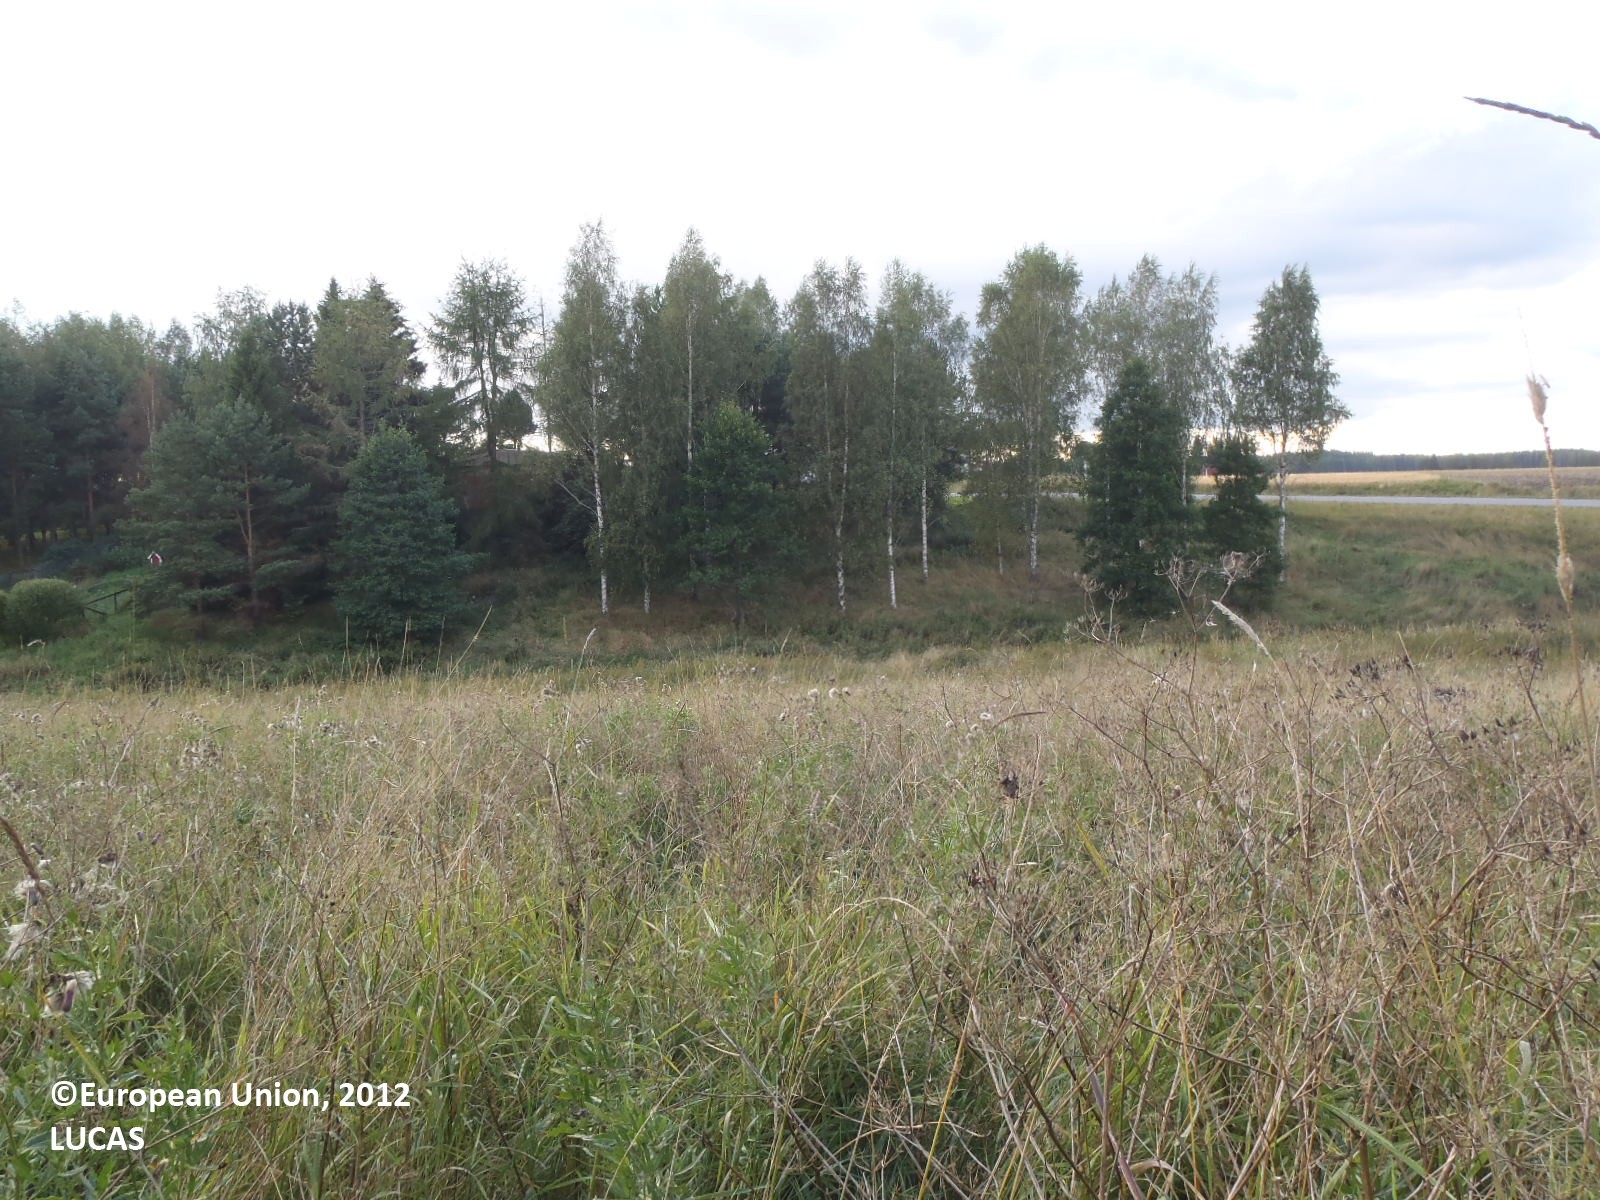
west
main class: Grassland
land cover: Grassland without tree/shrub cover
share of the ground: > 75 %
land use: Fallow land
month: August
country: FI
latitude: 60.6203
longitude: 22.7735
